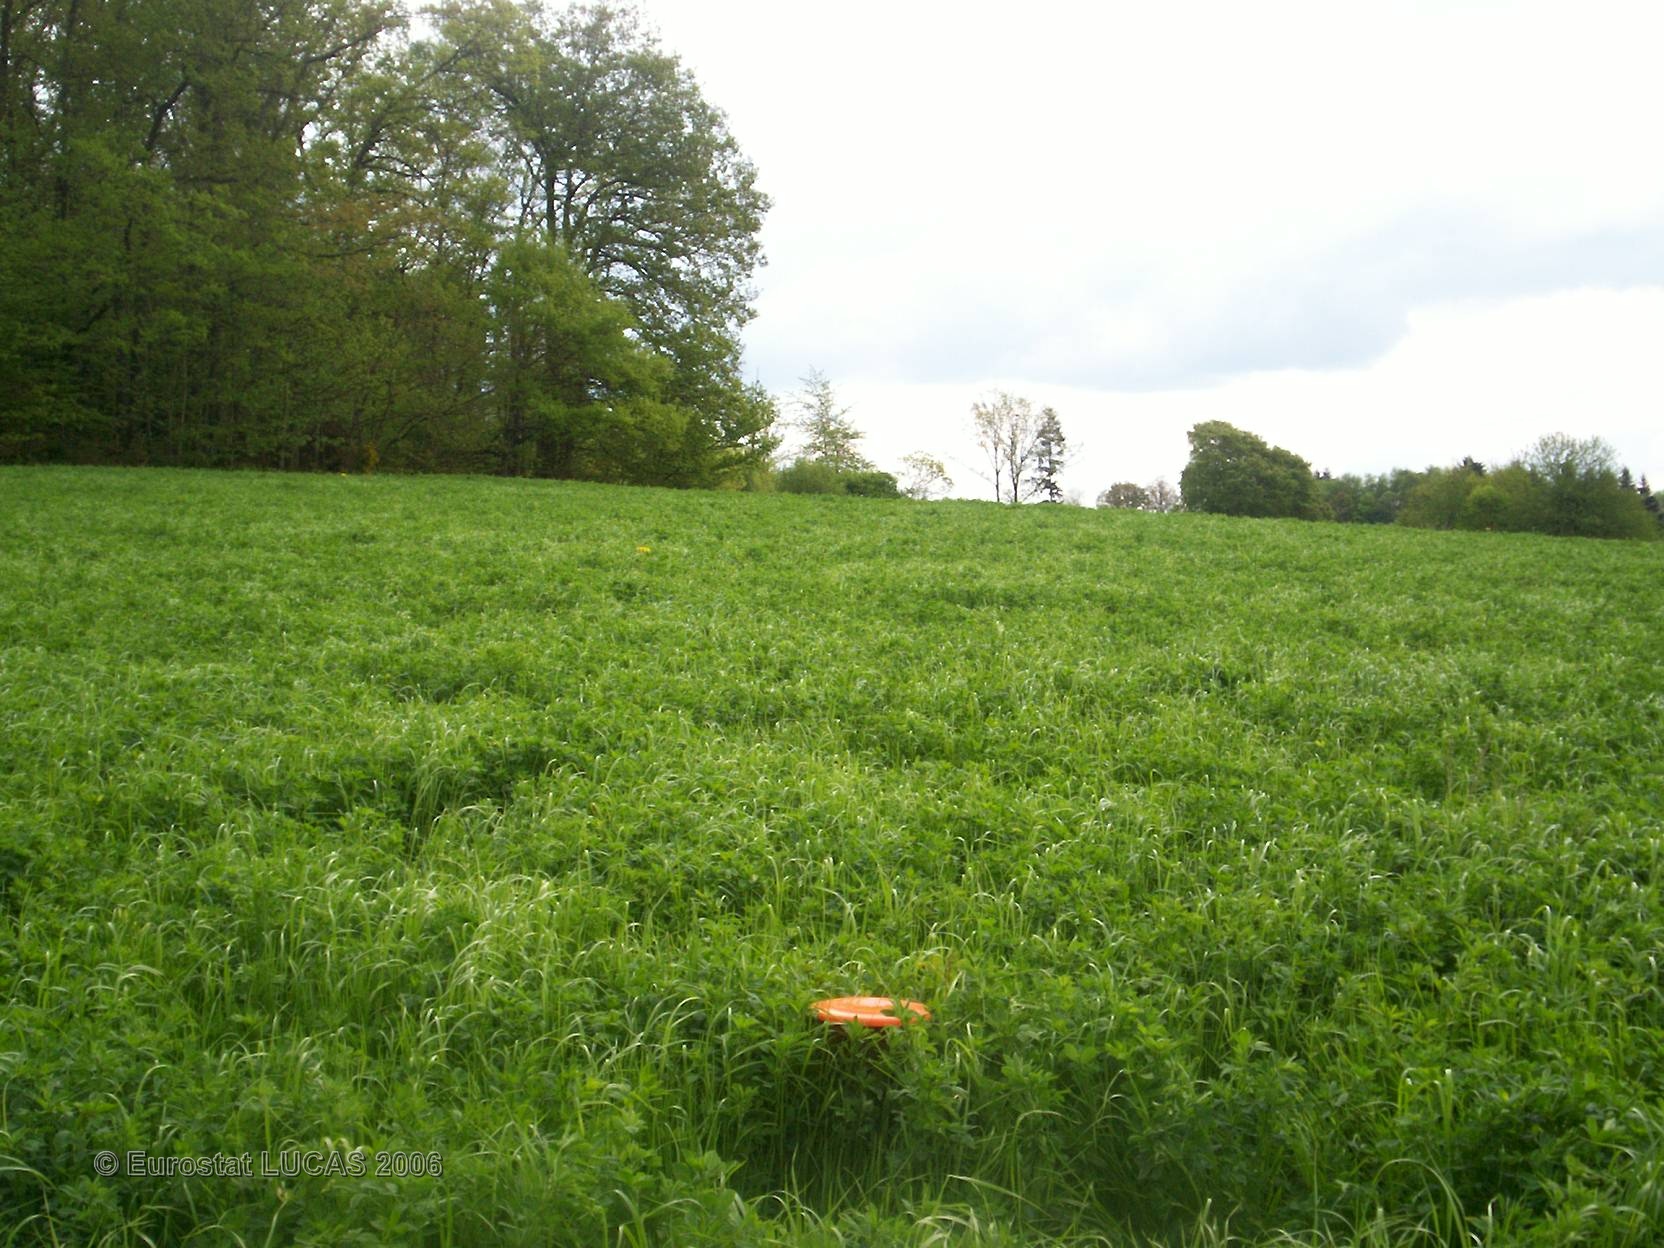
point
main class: Cropland
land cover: Lucerne
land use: Agriculture (excluding fallow land and kitchen gardens)
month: May
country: FR
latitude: 45.7446
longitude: 1.5482
